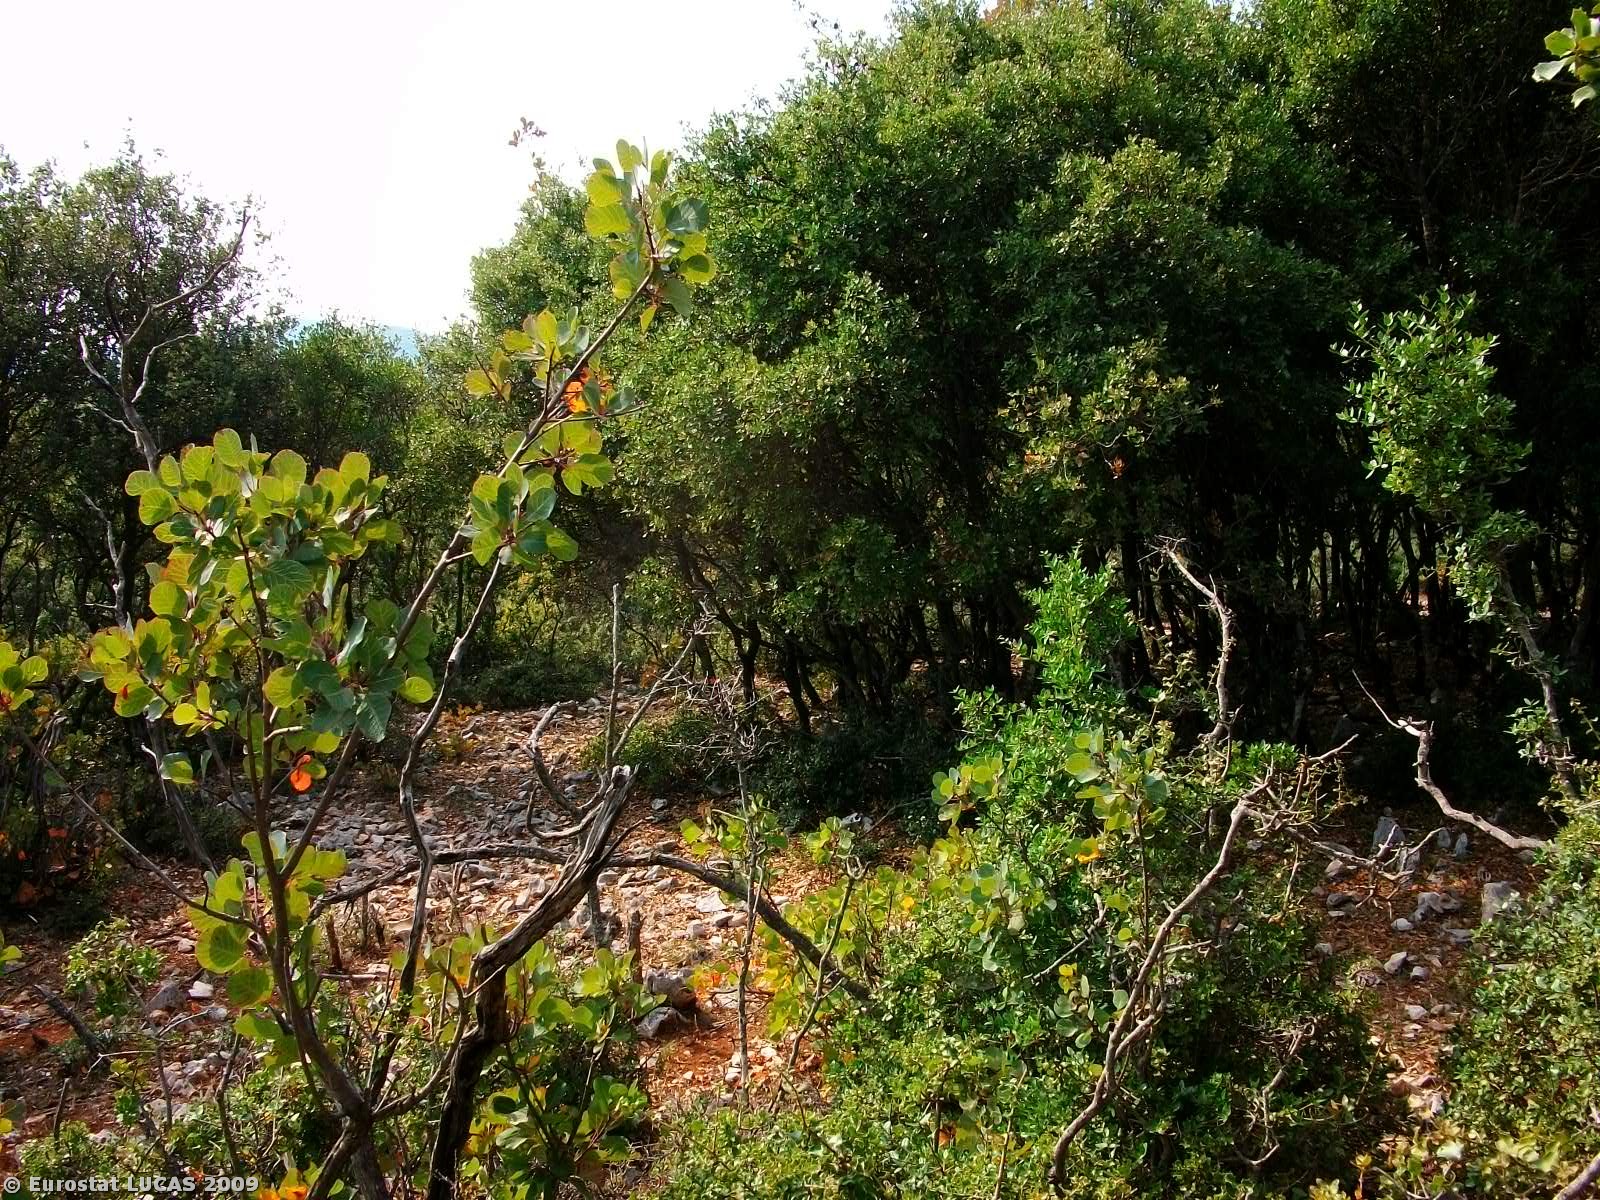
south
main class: Shrubland
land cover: Shrubland with sparse tree cover
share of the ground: 50 - 75 %
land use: Agriculture (excluding fallow land and kitchen gardens)
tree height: < 5 m
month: October
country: GR
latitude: 39.3584
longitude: 20.4762
